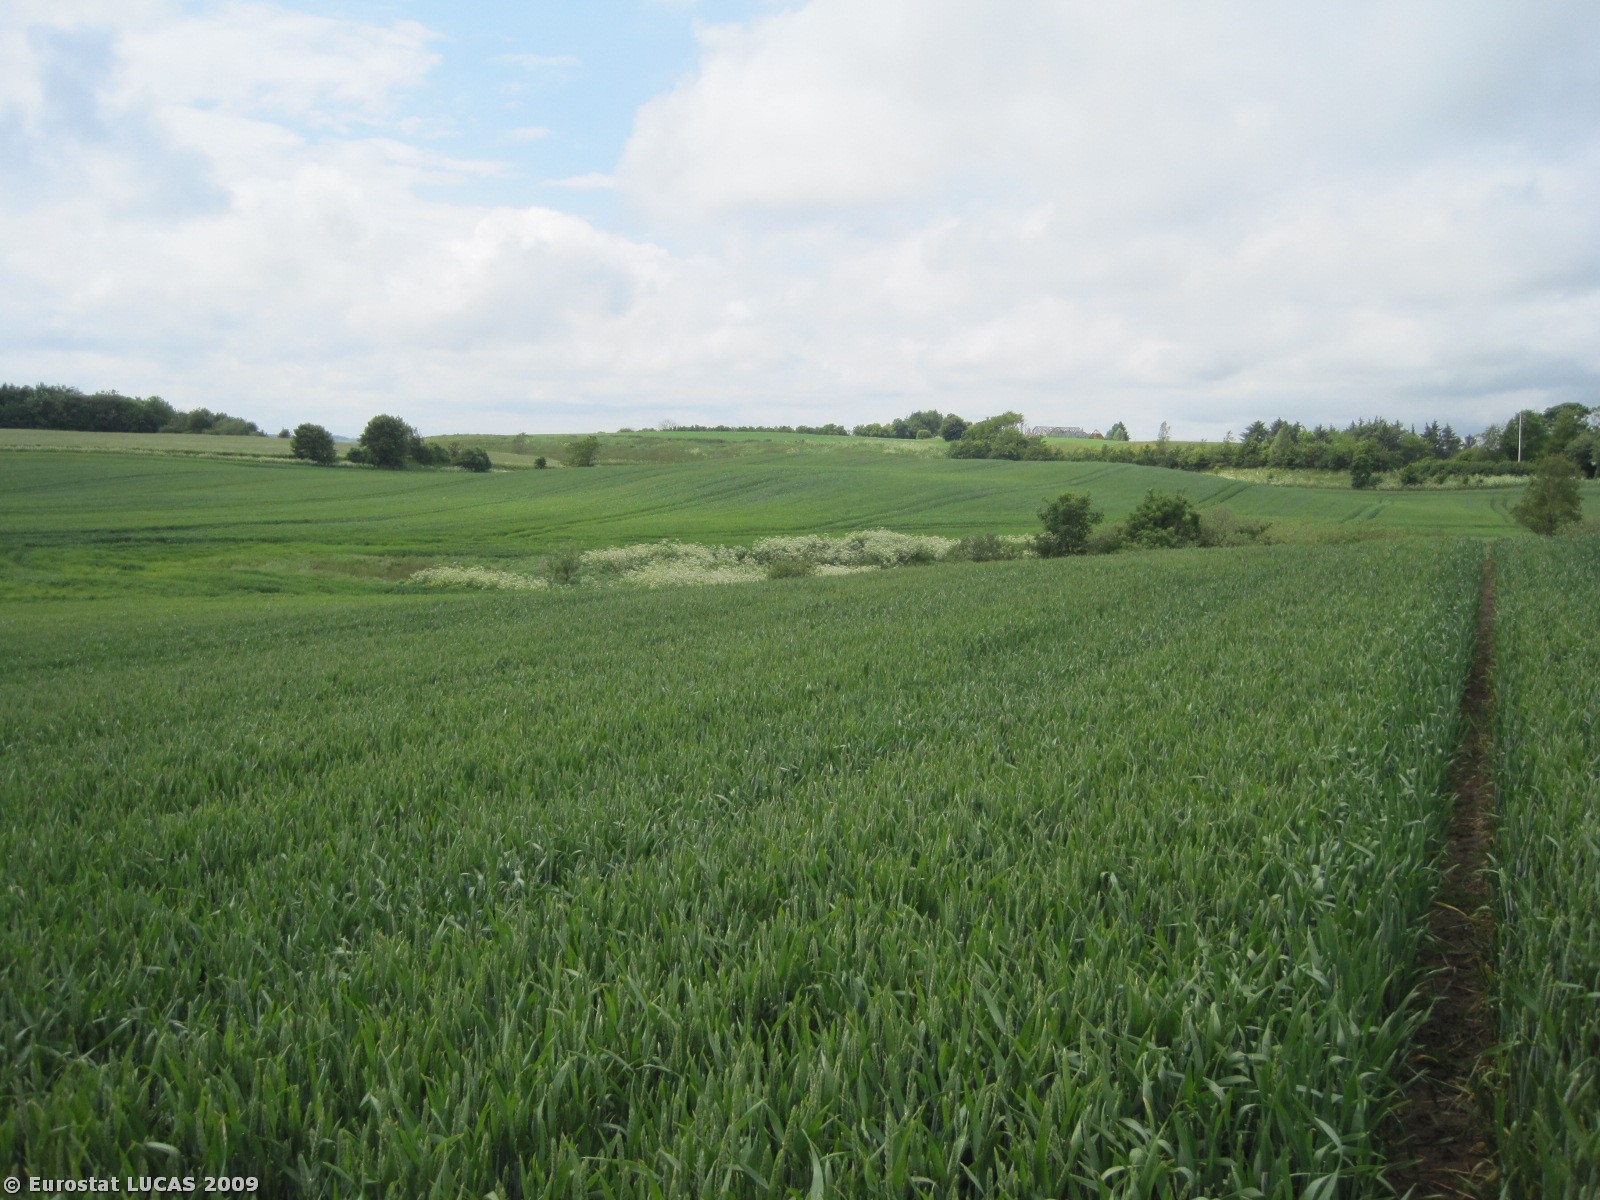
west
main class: Cropland
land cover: Common wheat
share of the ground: > 75 %
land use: Agriculture (excluding fallow land and kitchen gardens)
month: June
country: DK
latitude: 57.3561
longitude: 10.2489
